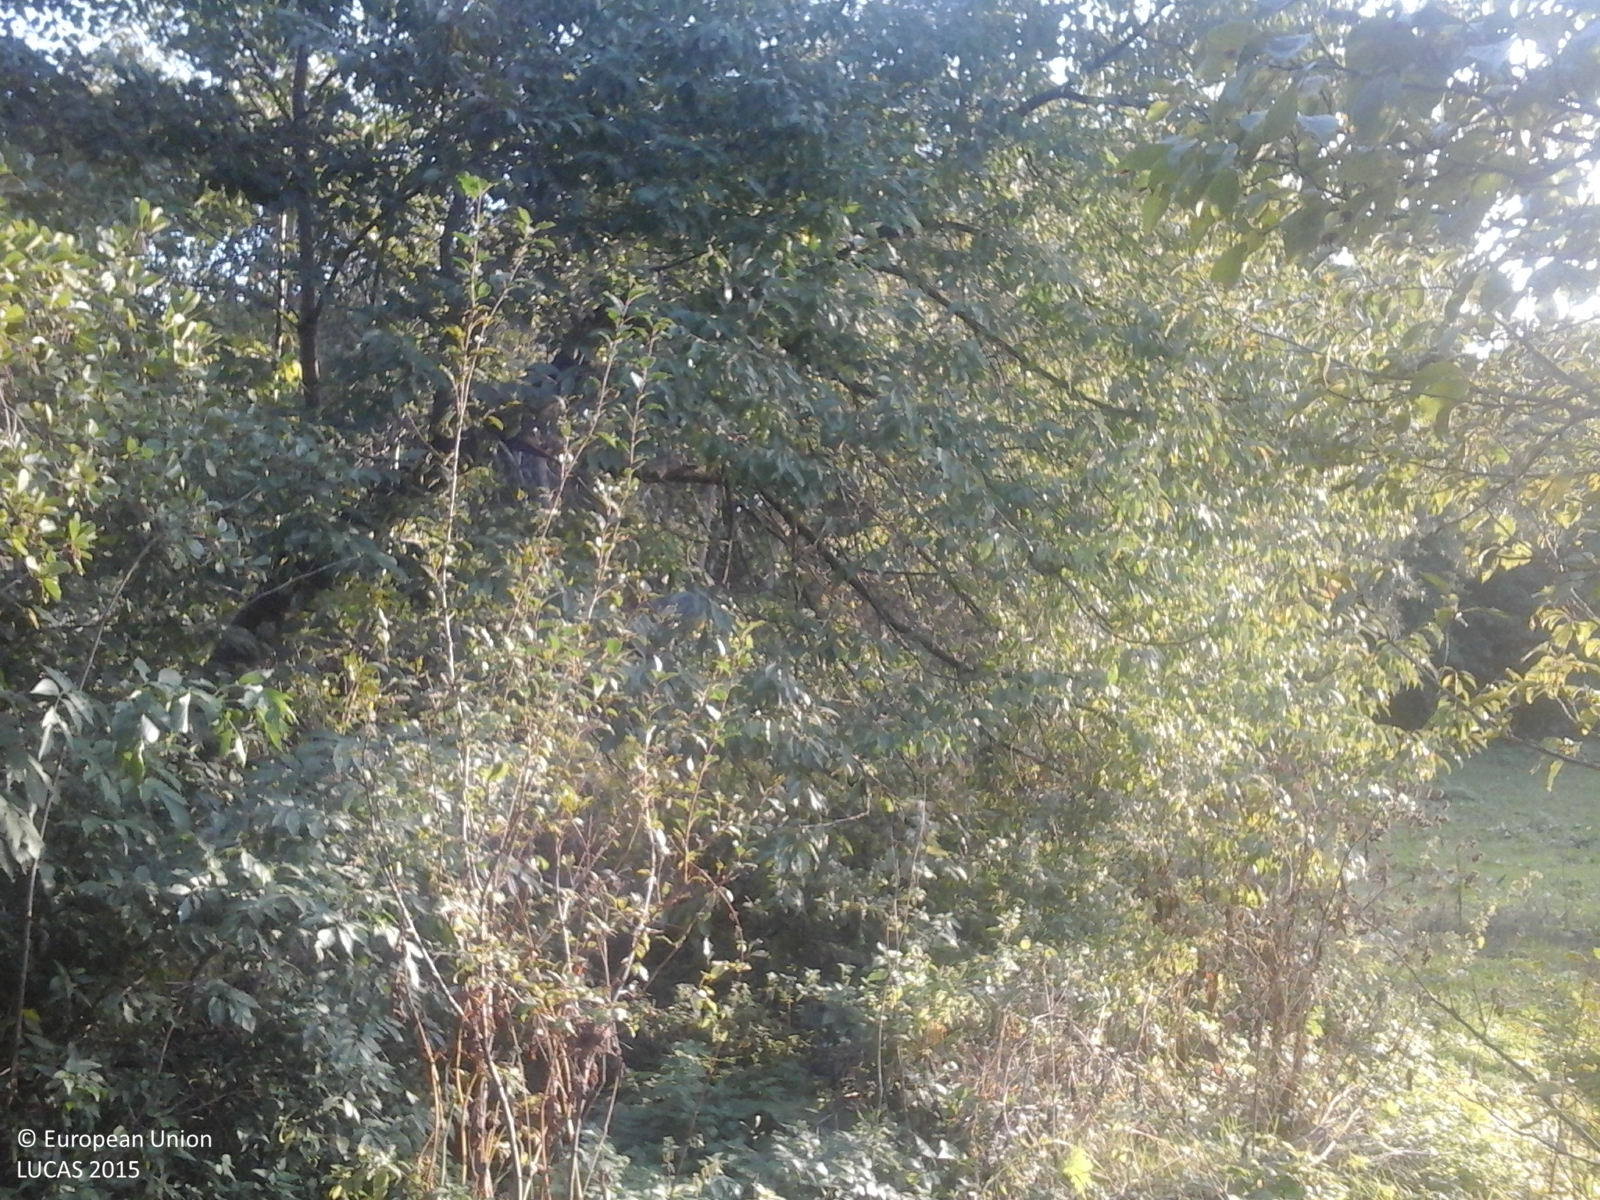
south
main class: Woodland
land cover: Broadleaved woodland
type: acidophilous oak and oak-birch forest
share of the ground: > 75 %
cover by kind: broadleaved forest trees 100 %
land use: Forestry
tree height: > 5 m
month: October
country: RO
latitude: 46.2714
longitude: 25.4036
